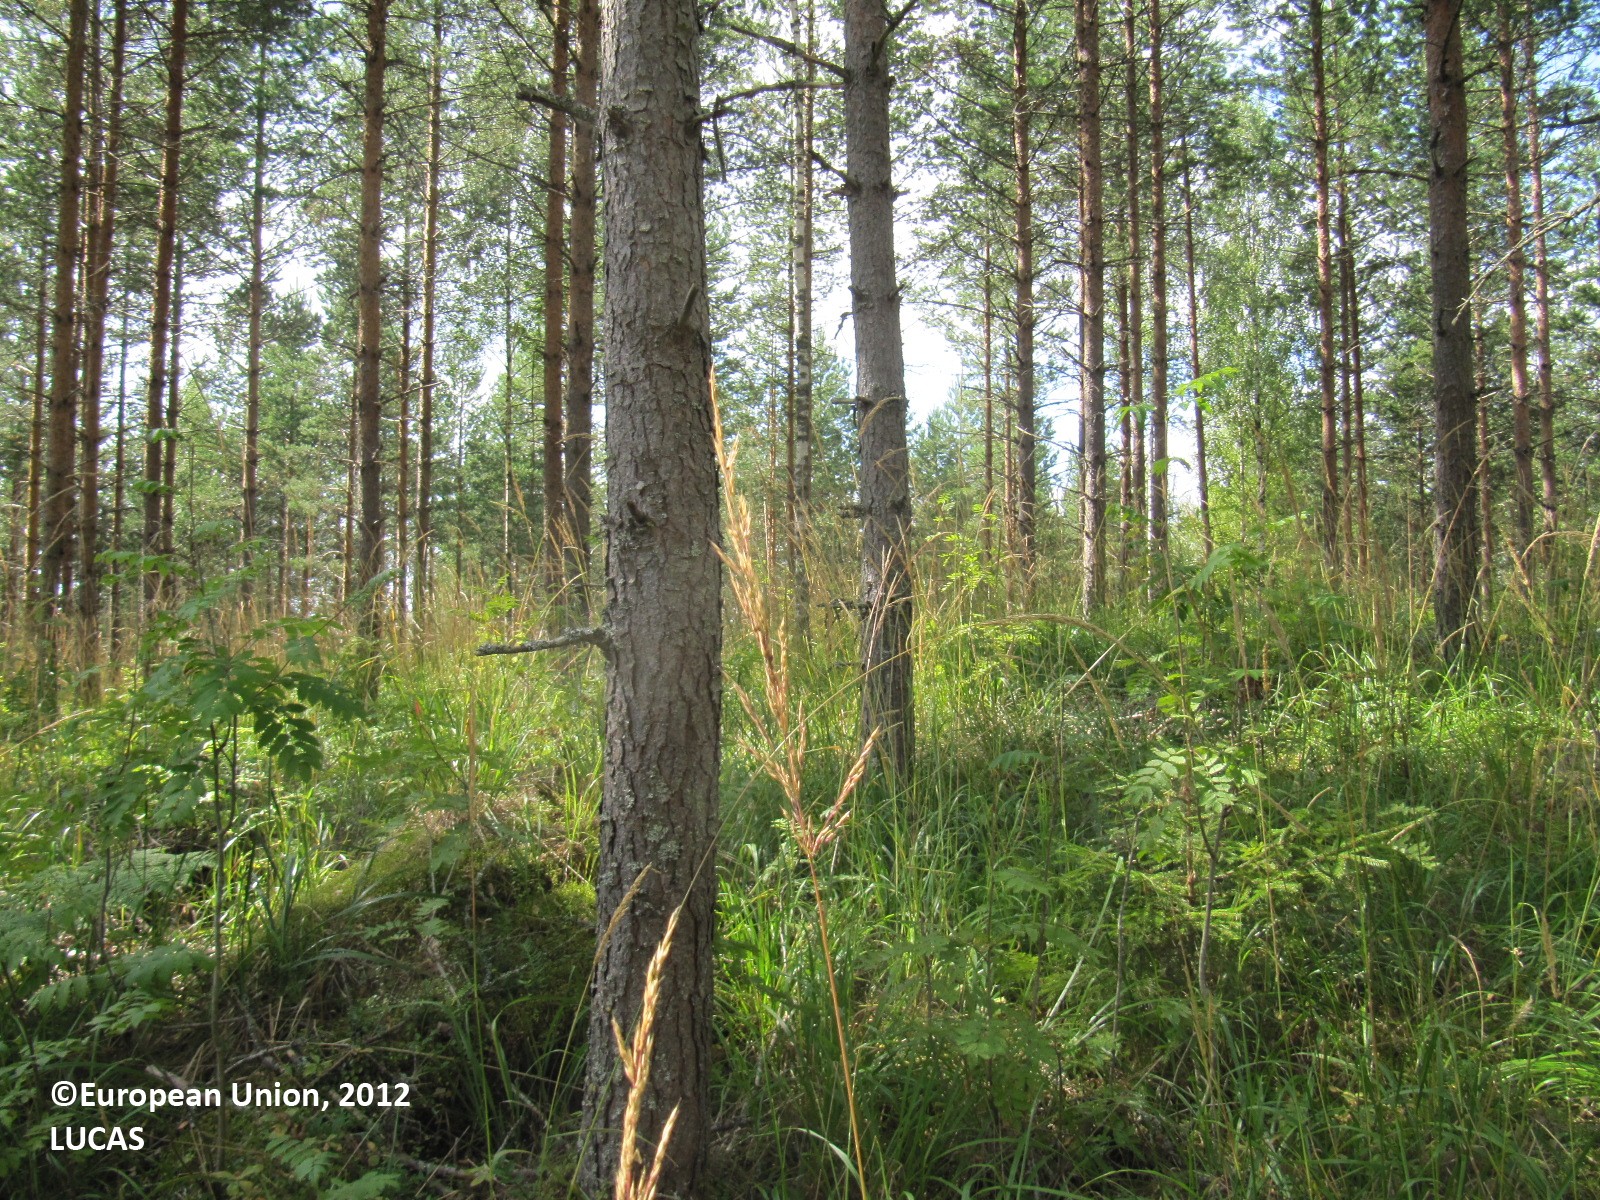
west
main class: Woodland
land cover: Pine dominated mixed woodland
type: boreal forest
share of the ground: 50 - 75 %
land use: Forestry
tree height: > 5 m
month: August
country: FI
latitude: 60.6911
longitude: 24.3309
